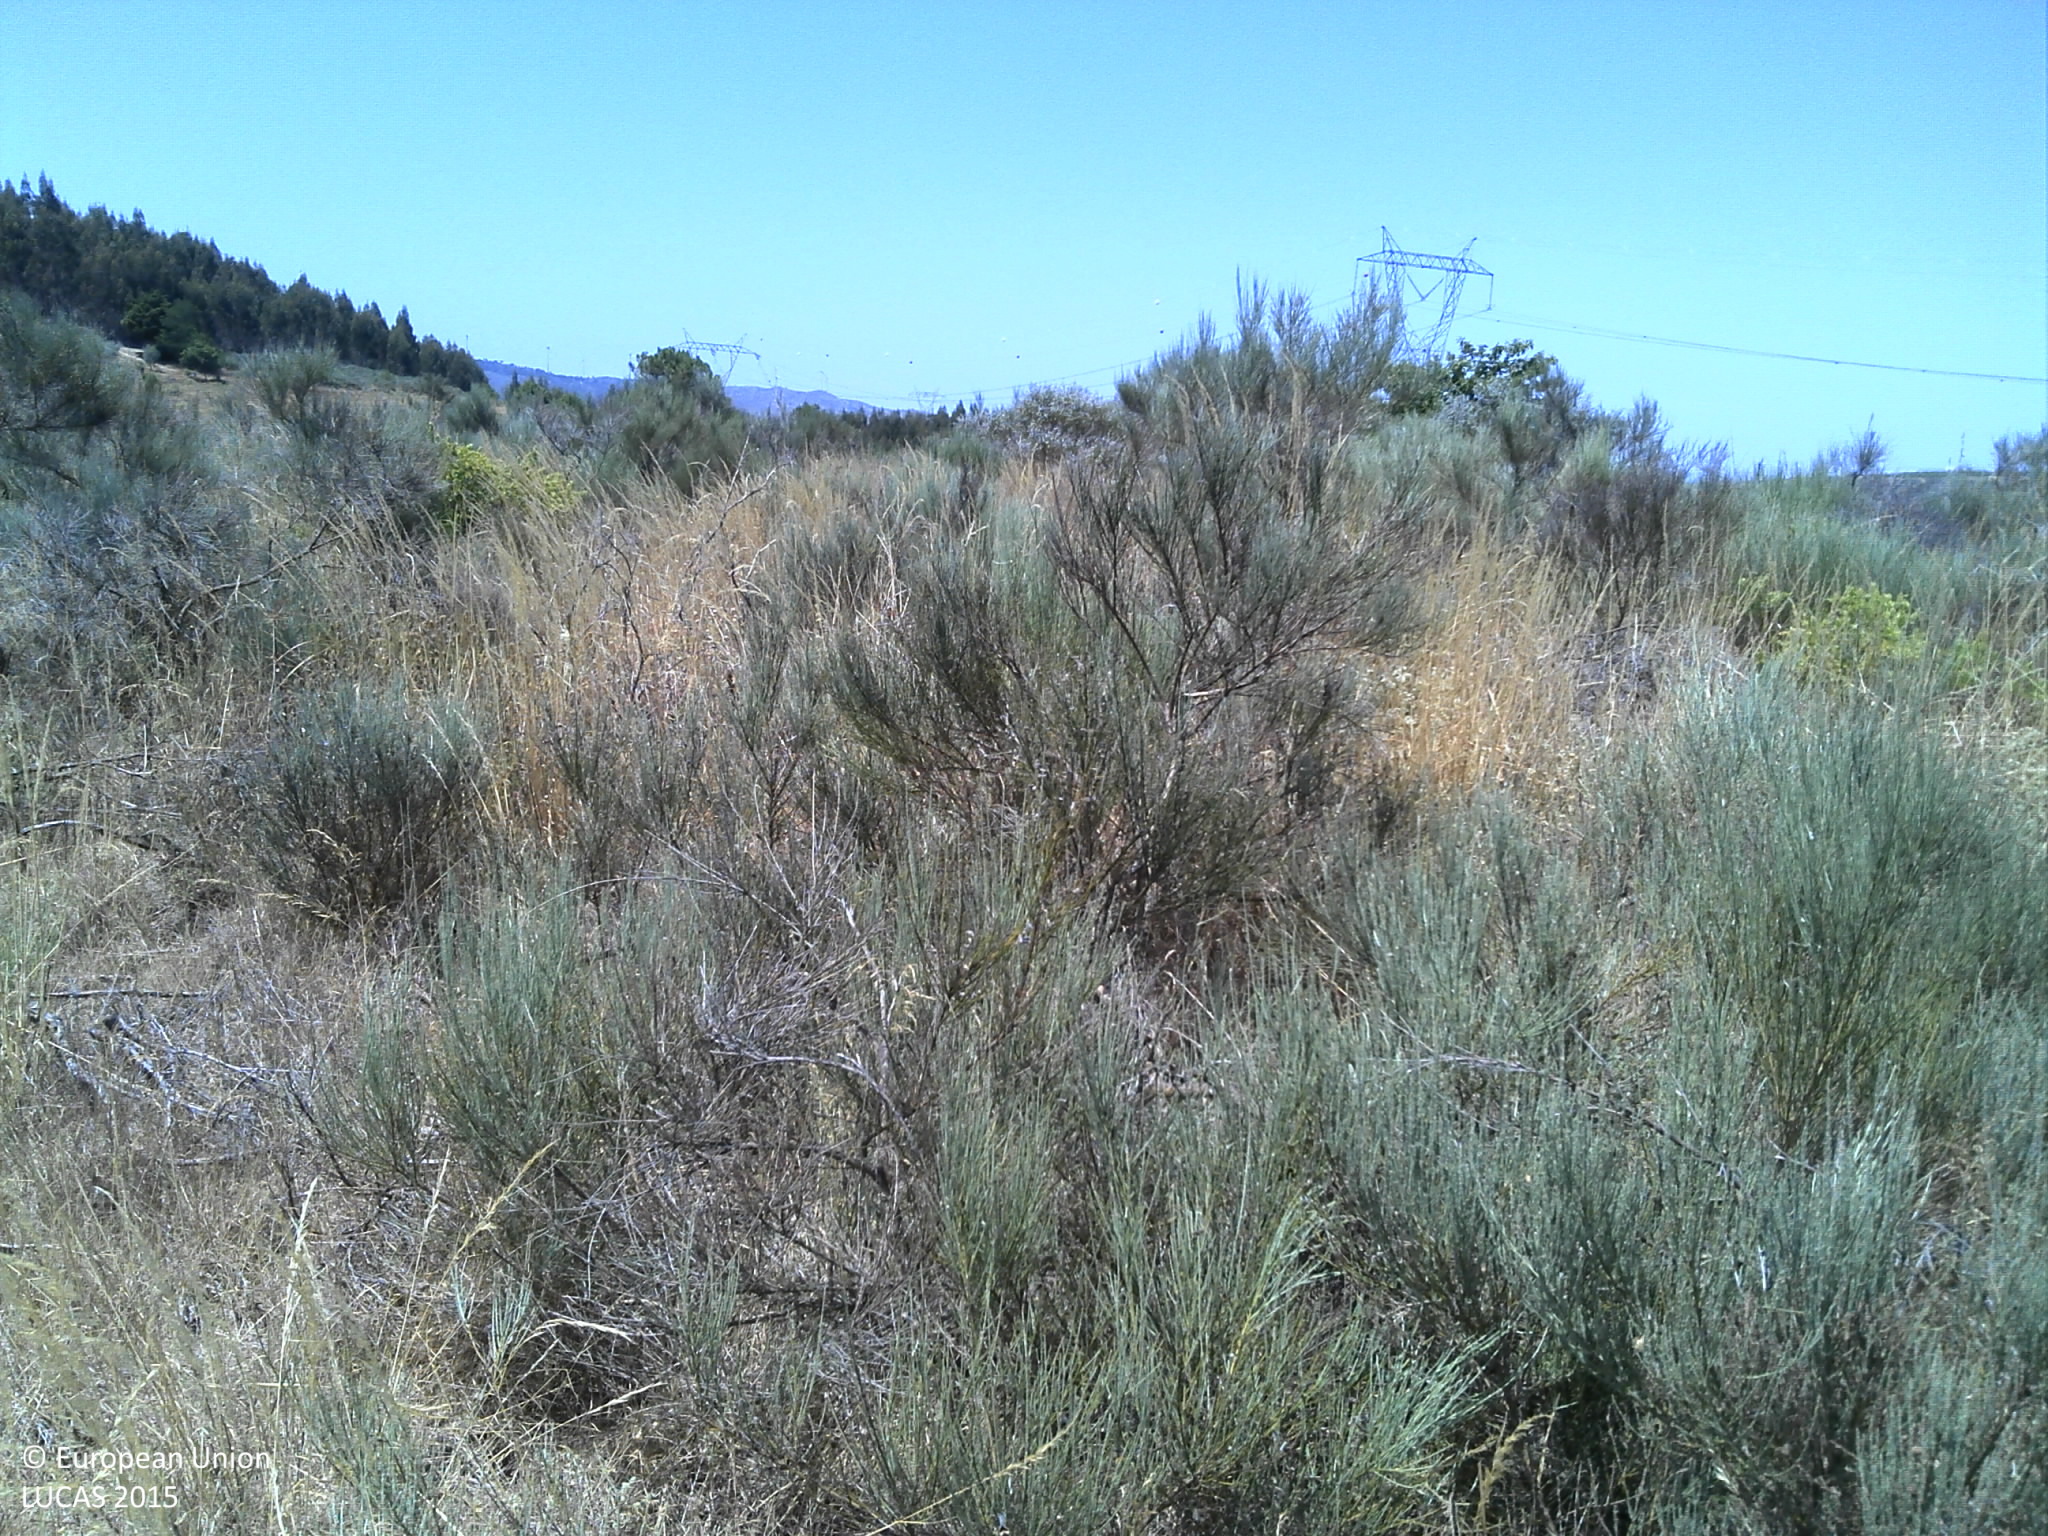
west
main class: Shrubland
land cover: Shrubland without tree cover
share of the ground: 50 - 75 %
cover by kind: shrubs 65 %, herbaceous plants 35 %
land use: Semi-natural and natural areas not in use
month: July
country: PT
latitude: 41.1035
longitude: -7.4688
